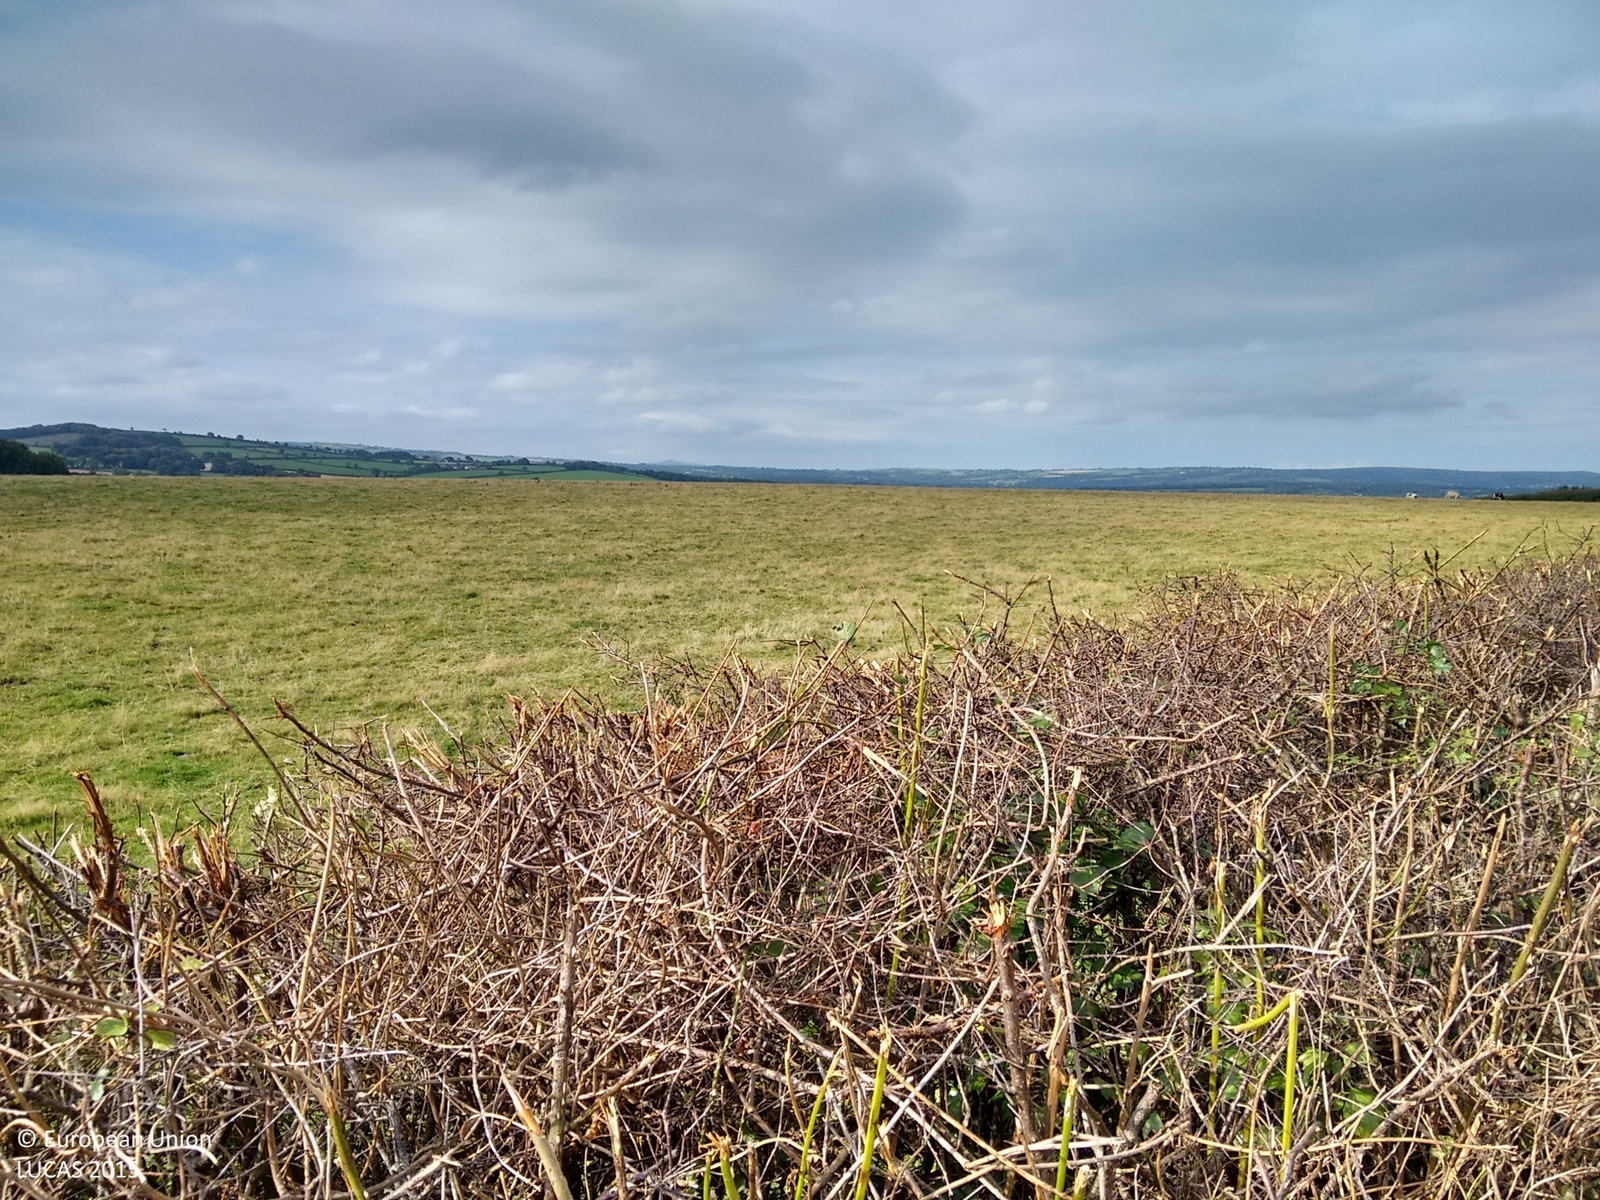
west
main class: Grassland
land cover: Grassland without tree/shrub cover
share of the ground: > 75 %
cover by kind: herbaceous plants 100 %
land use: Agriculture (excluding fallow land and kitchen gardens)
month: September
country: GB
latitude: 52.0582
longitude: -4.5604
